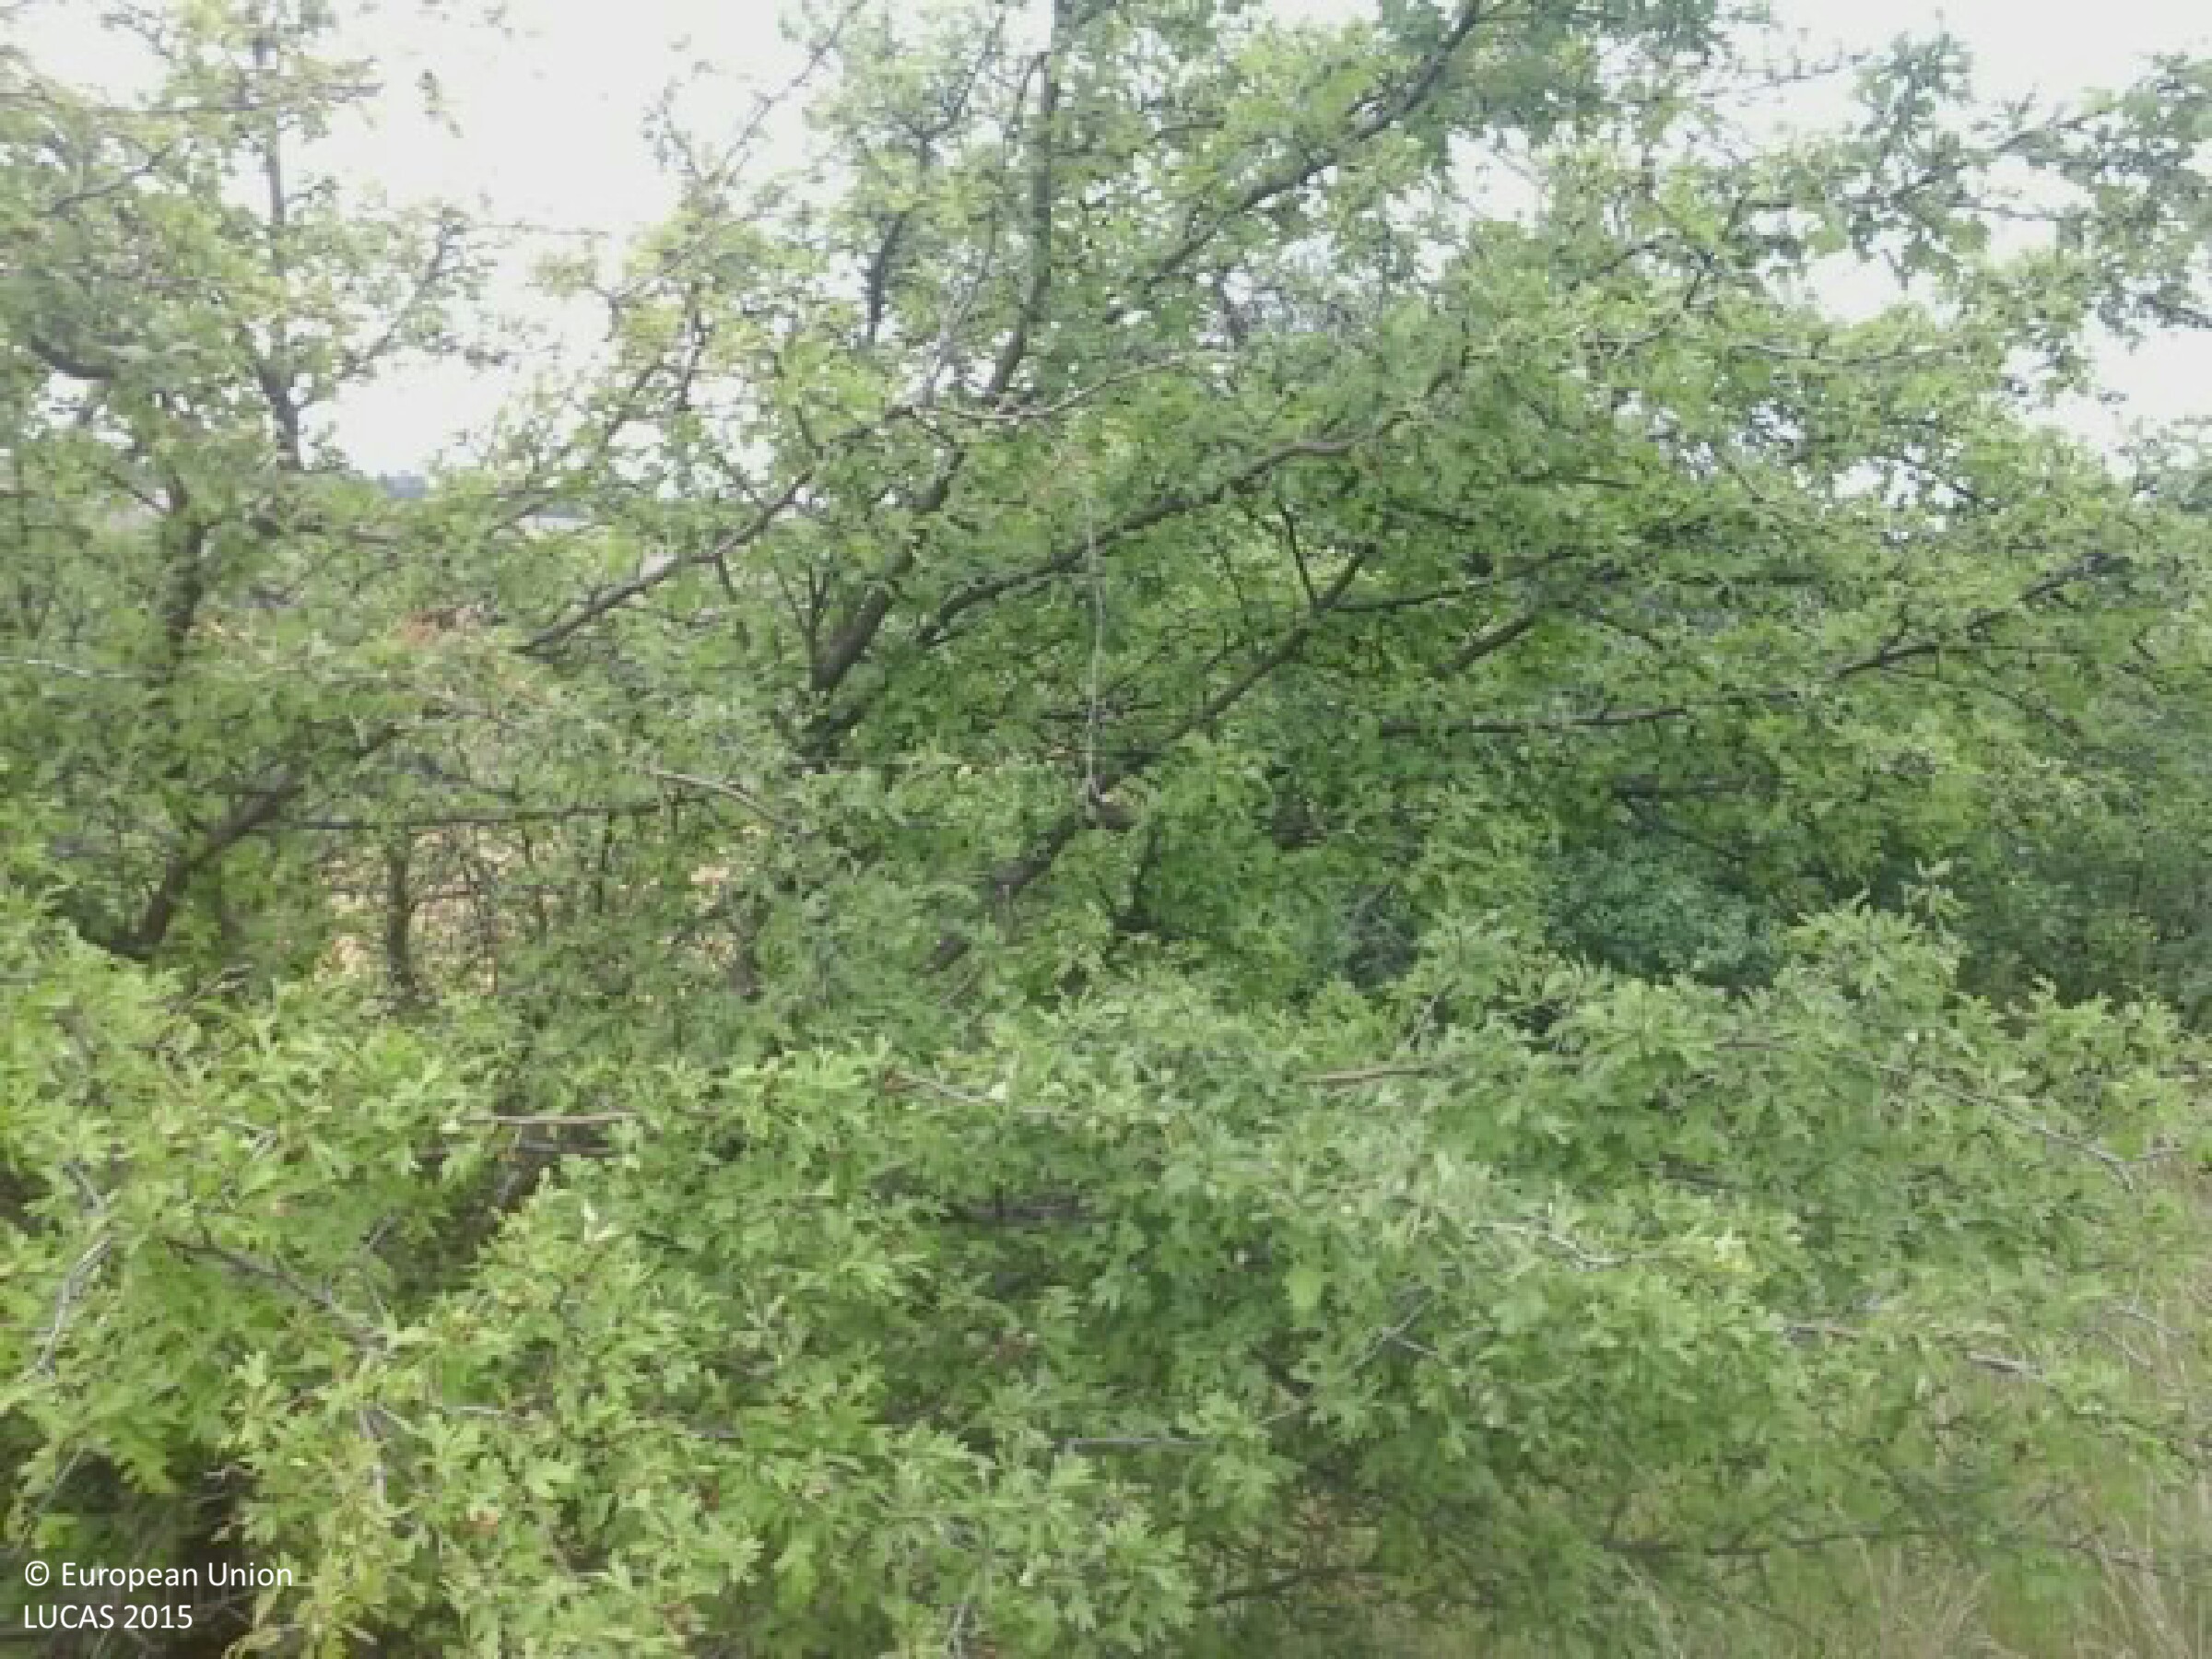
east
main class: Woodland
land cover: Broadleaved woodland
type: mesophytic deciduous forest
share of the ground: 25 - 50 %
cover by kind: herbaceous plants 50 %, broadleaved forest trees 40 %, shrubs 10 %
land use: Semi-natural and natural areas not in use
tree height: > 5 m
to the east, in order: Broadleaved woodland; Shrubland without tree cover; Broadleaved woodland; Barley
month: June
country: HU
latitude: 47.4767
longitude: 19.4020
